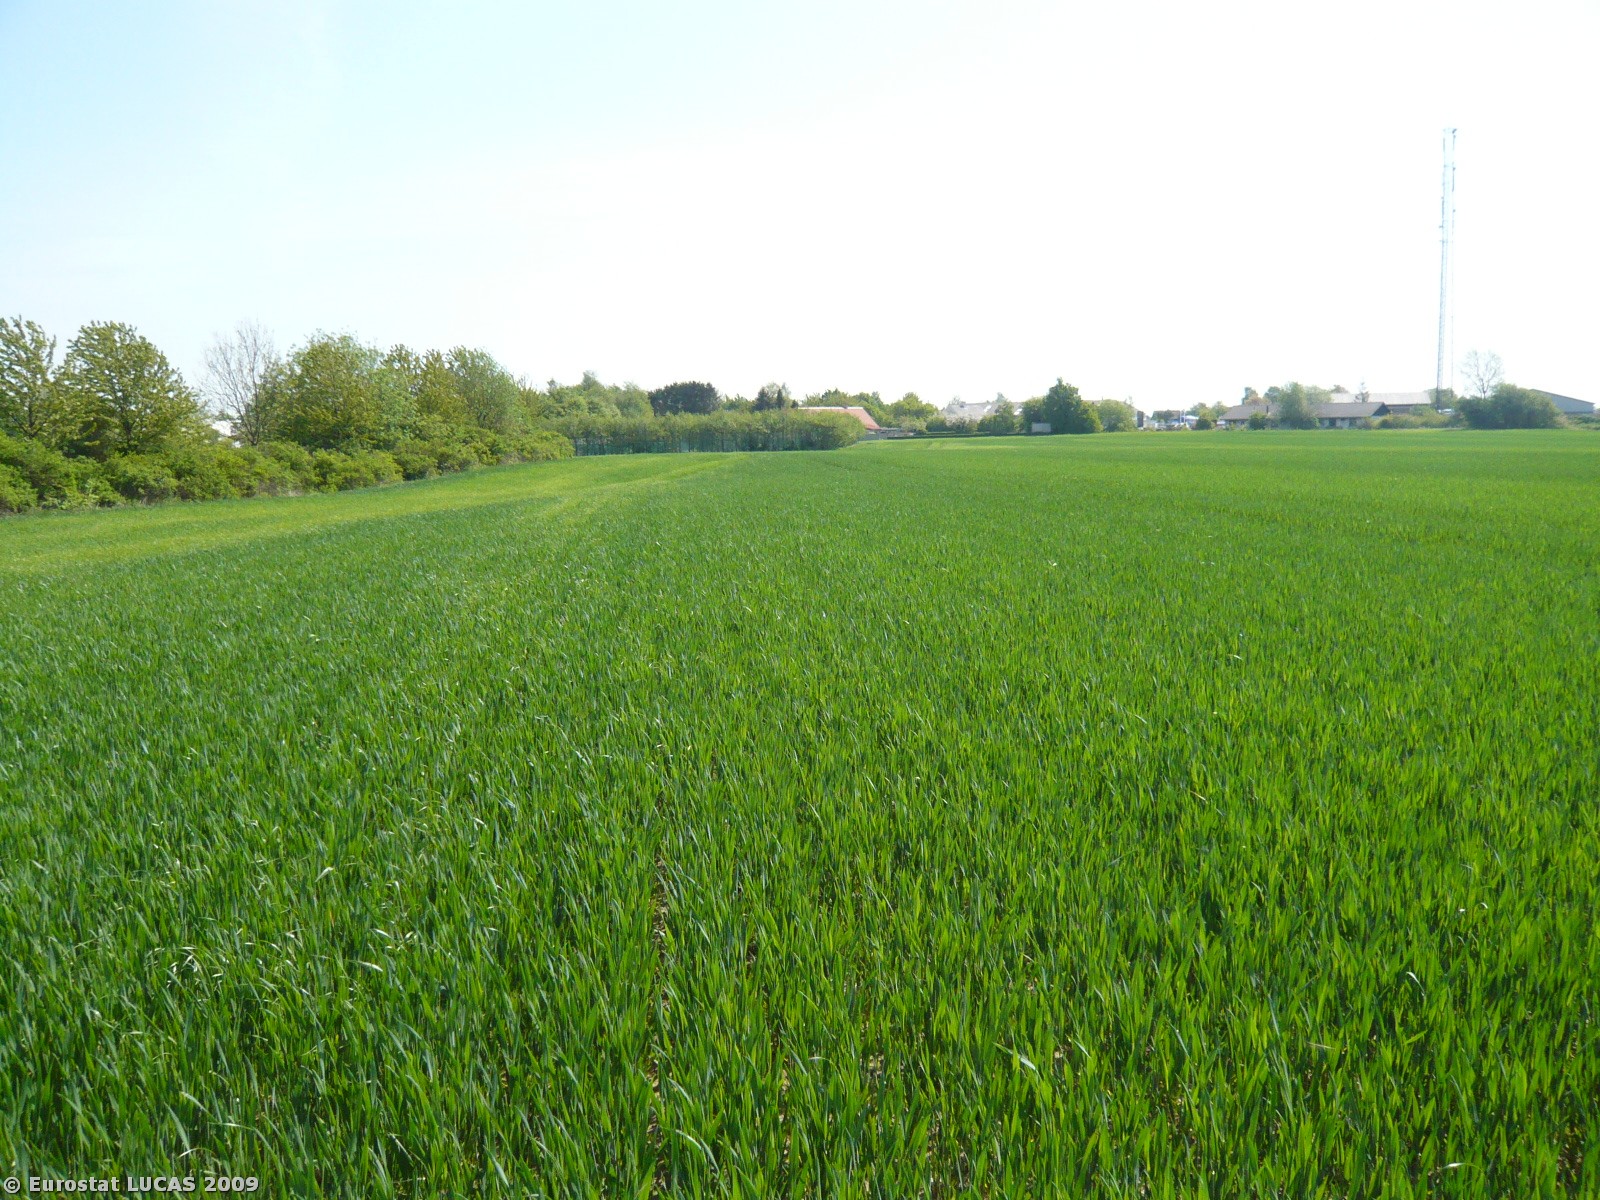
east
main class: Cropland
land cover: Common wheat
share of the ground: > 75 %
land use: Agriculture (excluding fallow land and kitchen gardens)
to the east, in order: Common wheat; Broadleaved woodland; Artificial constructions in urban areas; Grassland without tree/shrub cover; Paved roads, cycling and walking lanes; Grass margins; Broadleaved woodland
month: May
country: DK
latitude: 55.3060
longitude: 12.1881
